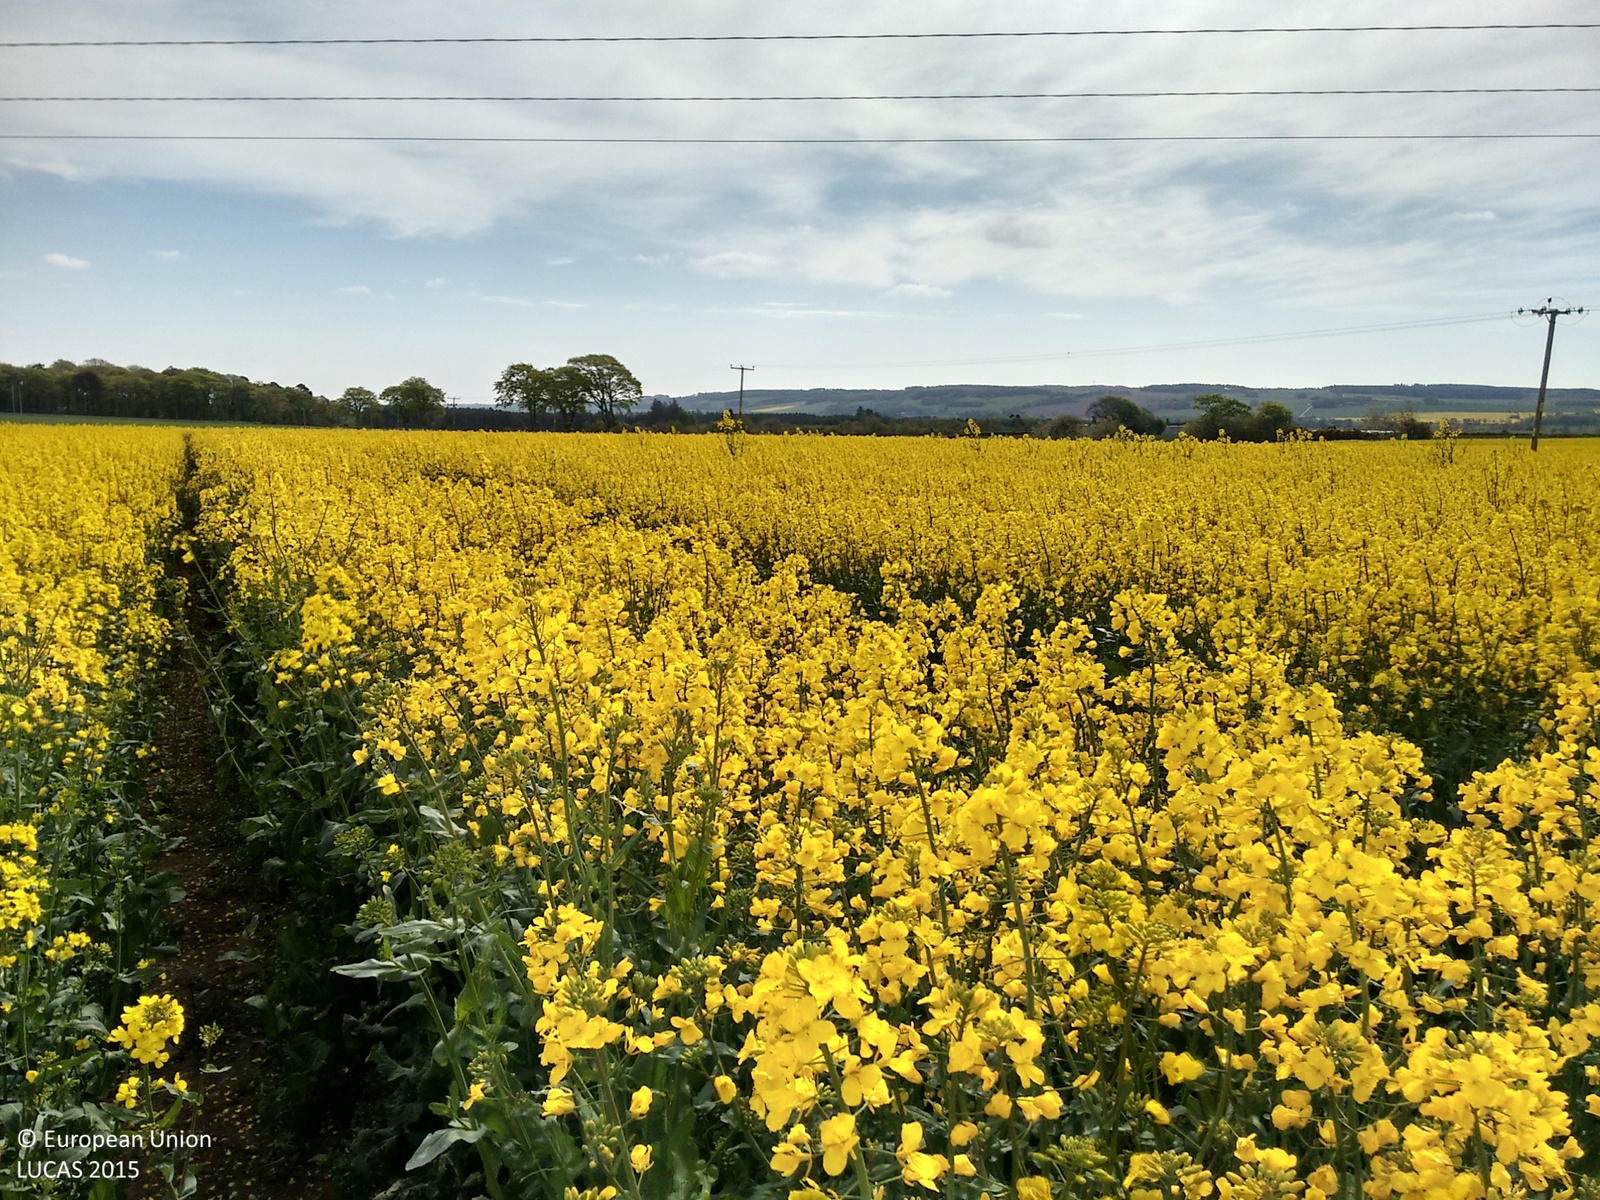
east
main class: Cropland
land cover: Rape and turnip rape
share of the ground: > 75 %
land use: Agriculture (excluding fallow land and kitchen gardens)
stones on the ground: 10 - 25 %
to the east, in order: Rape and turnip rape; Electric lines; Rape and turnip rape; Ditches and canals; Grass margins; Ditches and canals; Barley
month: May
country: GB
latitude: 56.7066
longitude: -2.6527
